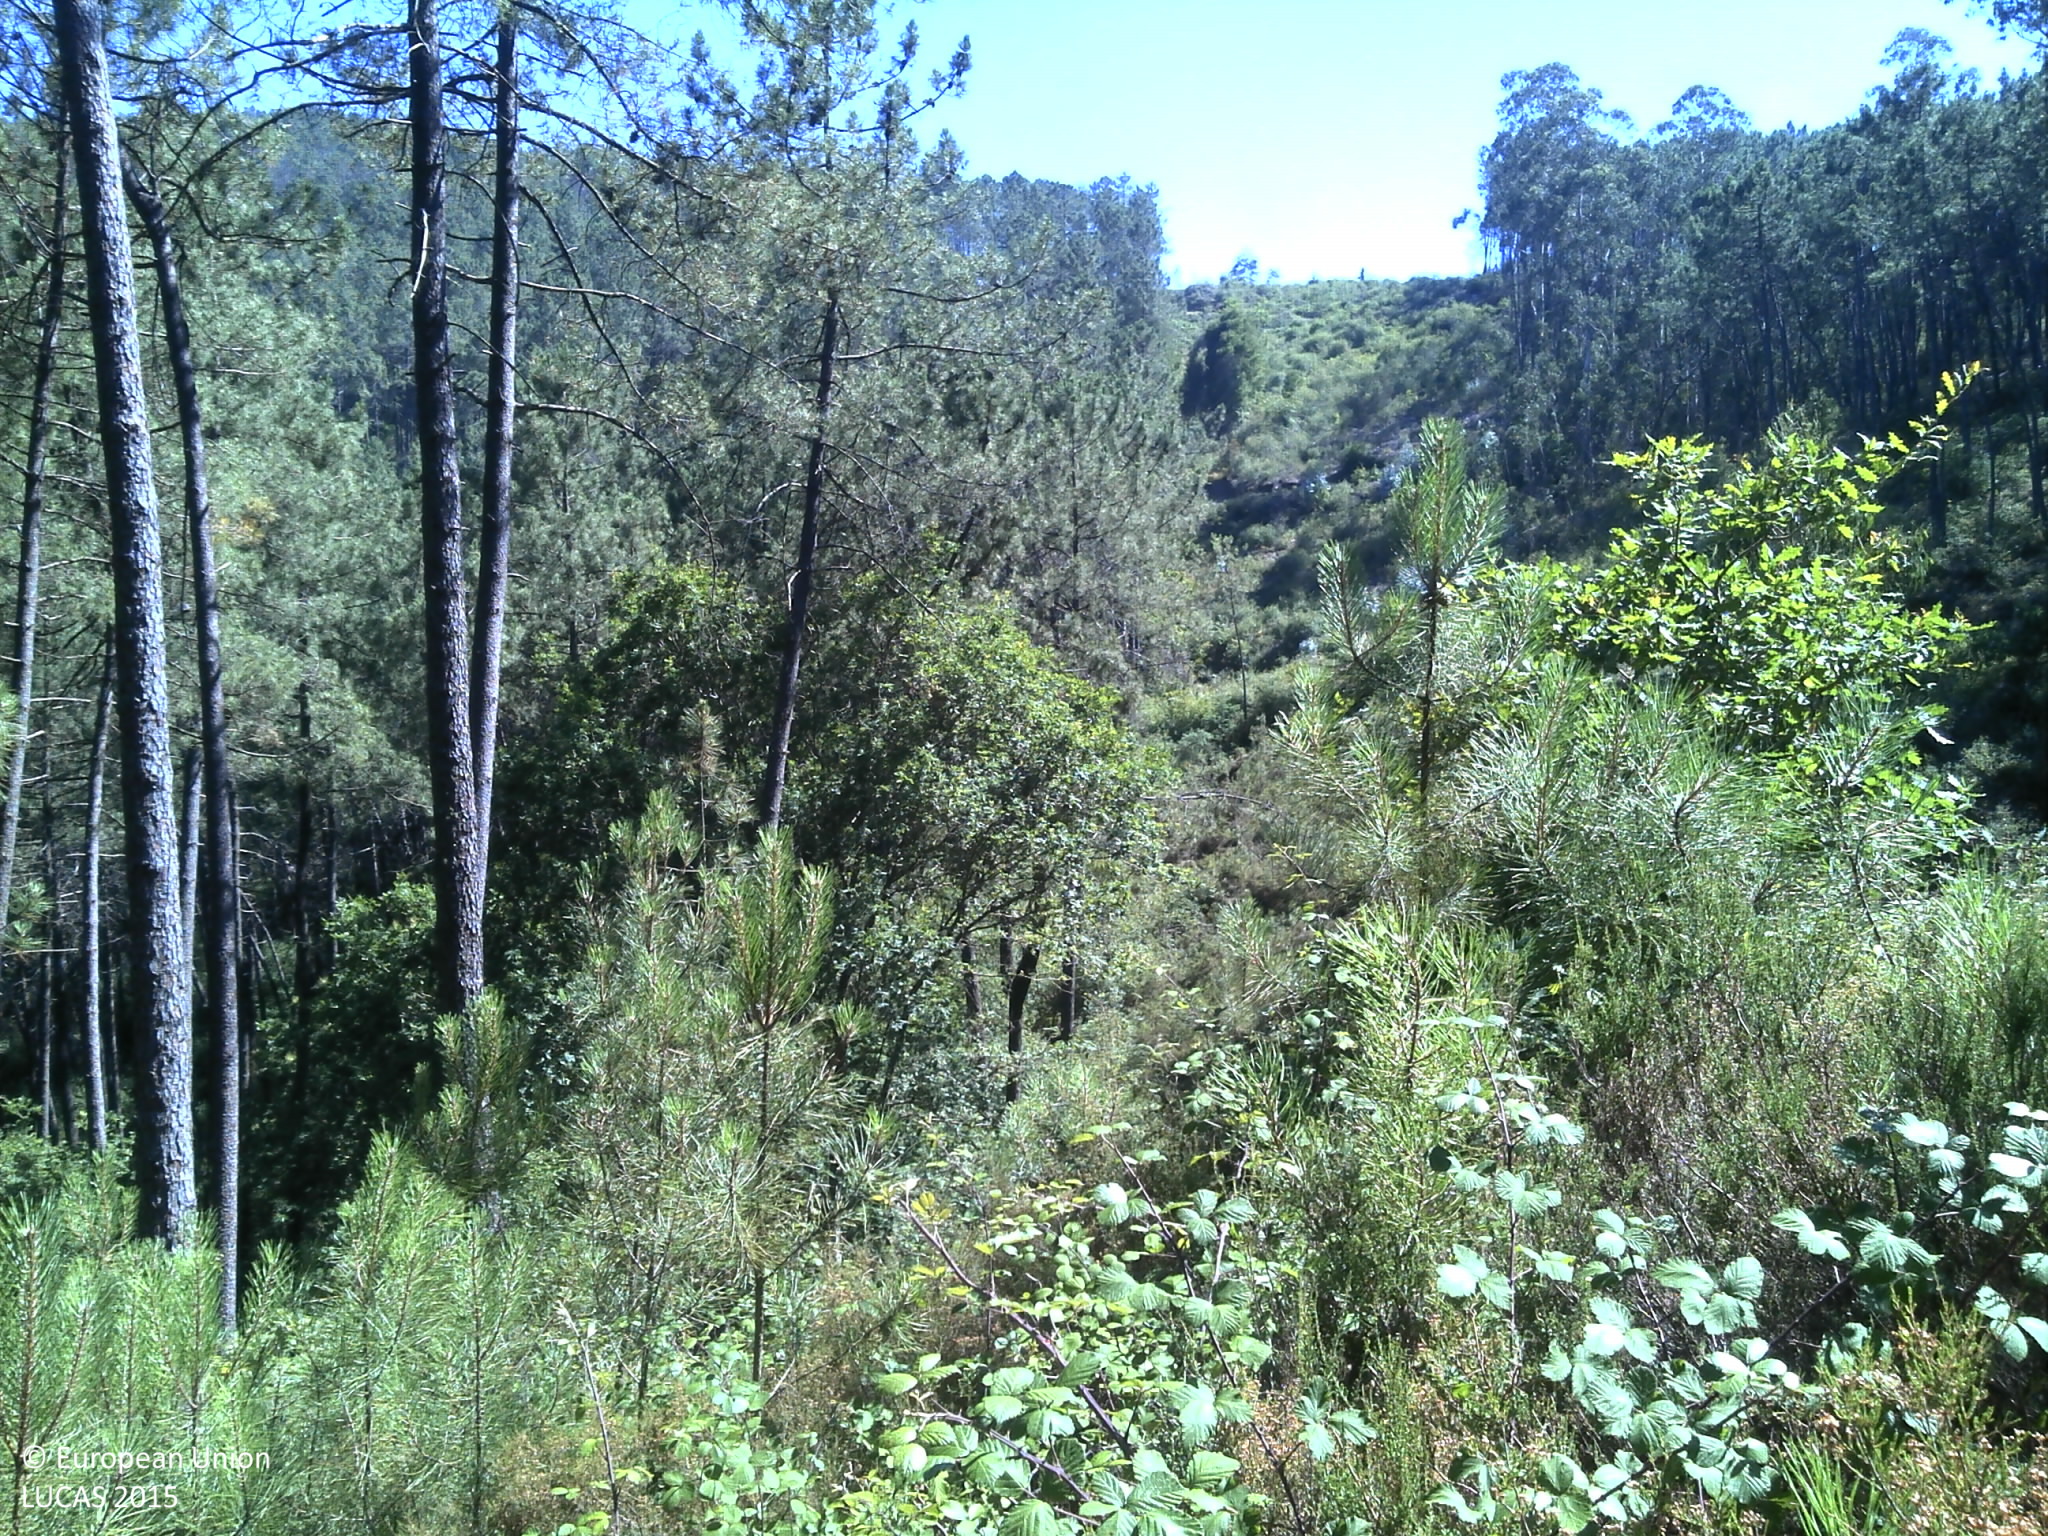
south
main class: Woodland
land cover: Pine dominated coniferous woodland
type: coniferous forest of the mediterranean region
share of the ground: 50 - 75 %
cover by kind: coniferous forest trees 60 %, shrubs 25 %, unconsolidated bare surface 15 %
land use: Forestry
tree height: > 5 m
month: June
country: PT
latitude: 40.6269
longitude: -8.2565
